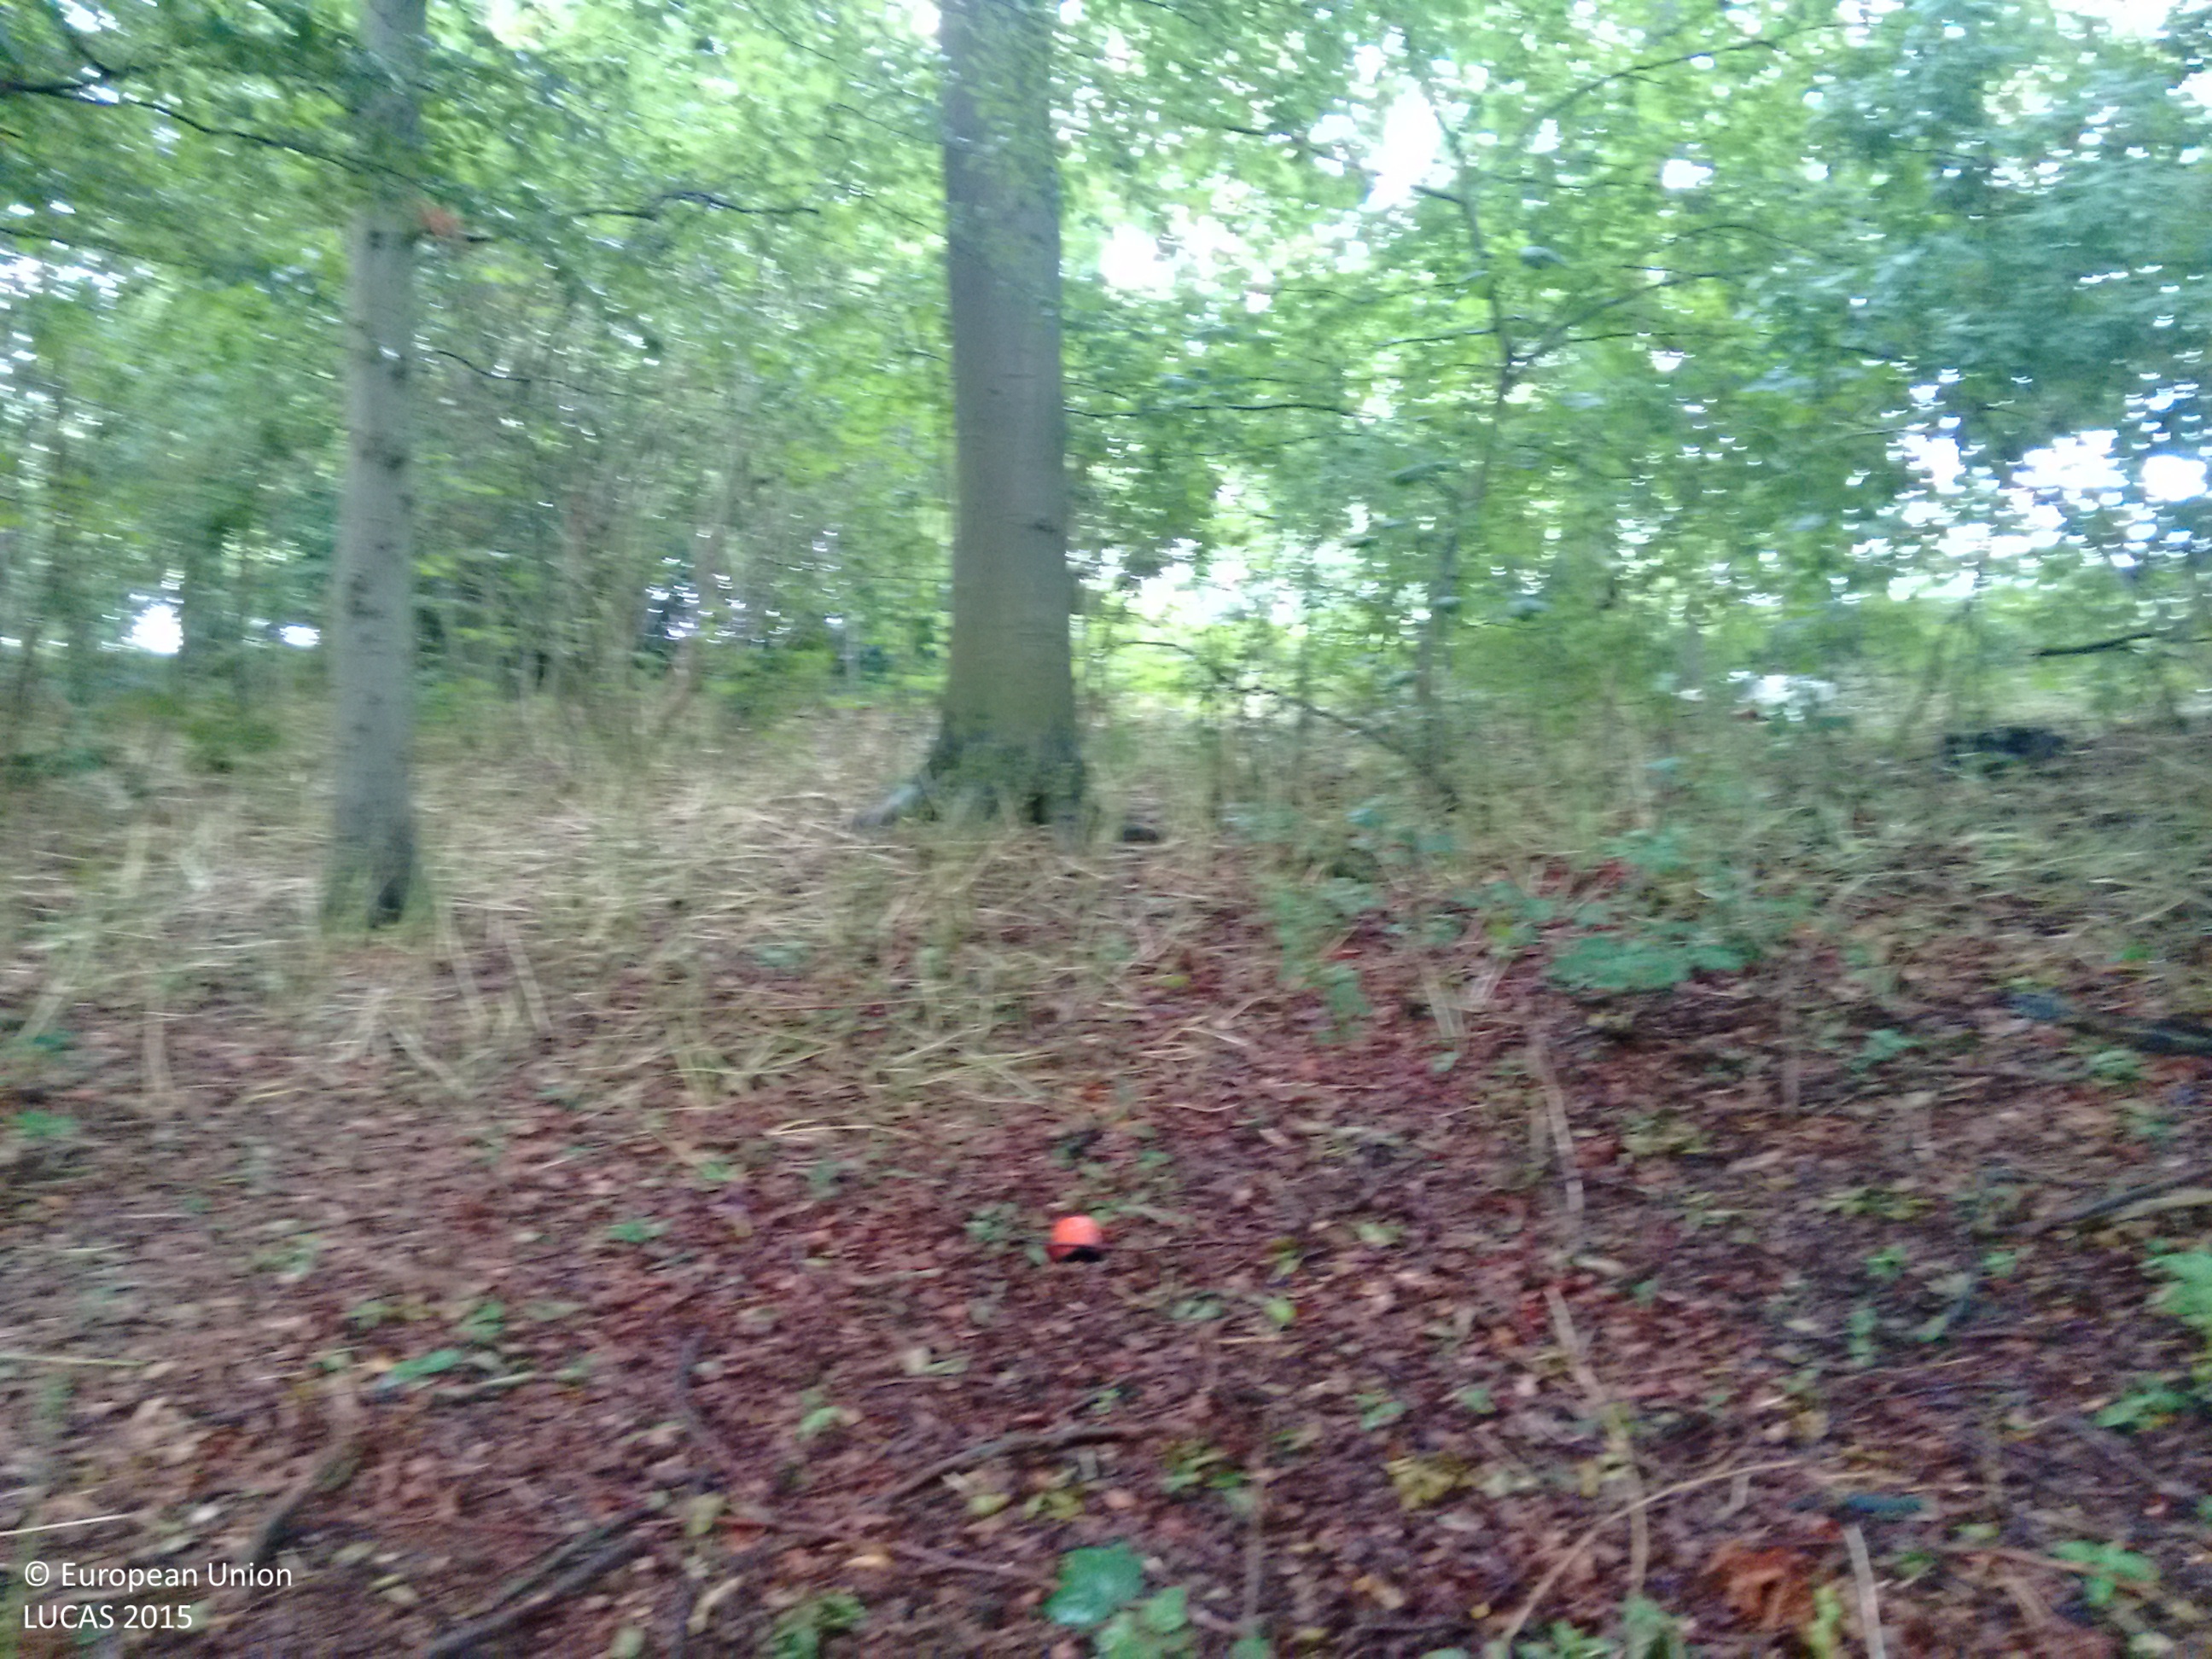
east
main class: Woodland
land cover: Broadleaved woodland
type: mesophytic deciduous forest
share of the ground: > 75 %
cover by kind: broadleaved forest trees 100 %
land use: Semi-natural and natural areas not in use
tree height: > 5 m
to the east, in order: Broadleaved woodland; Grass margins; Paved roads, cycling and walking lanes; Grass margins; Fences; Grass margins; Common wheat; Grass margins
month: July
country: GB
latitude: 54.5540
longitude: -1.7566
